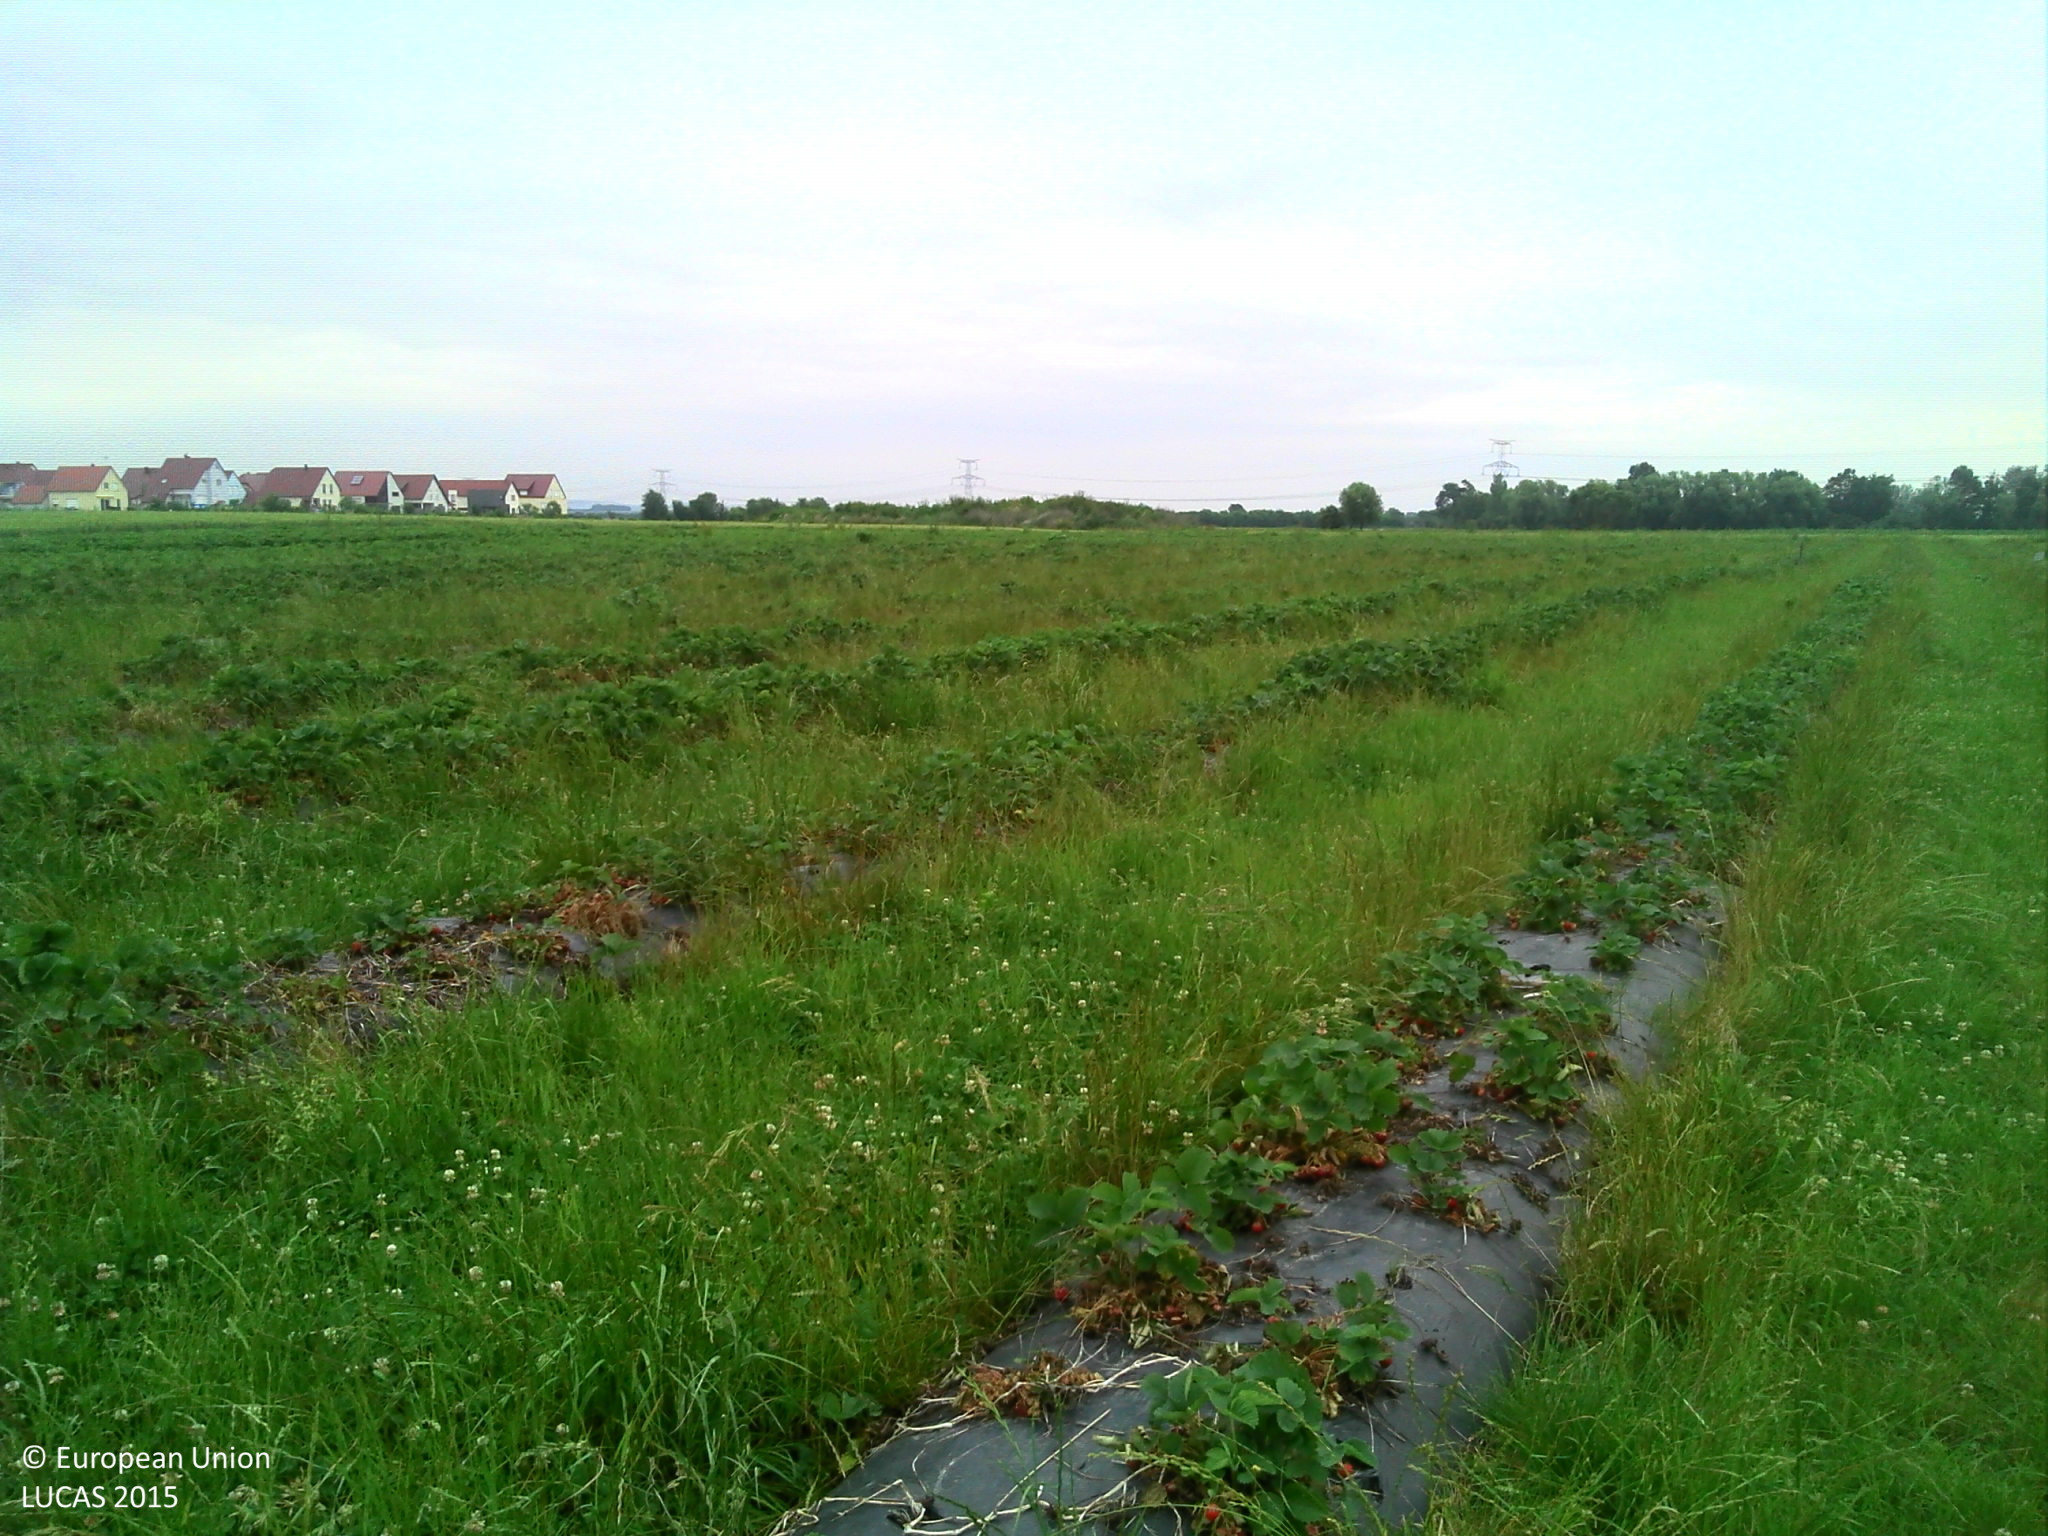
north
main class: Cropland
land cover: Strawberries
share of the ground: 50 - 75 %
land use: Agriculture (excluding fallow land and kitchen gardens)
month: June
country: FR
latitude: 48.4485
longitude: 7.5538
